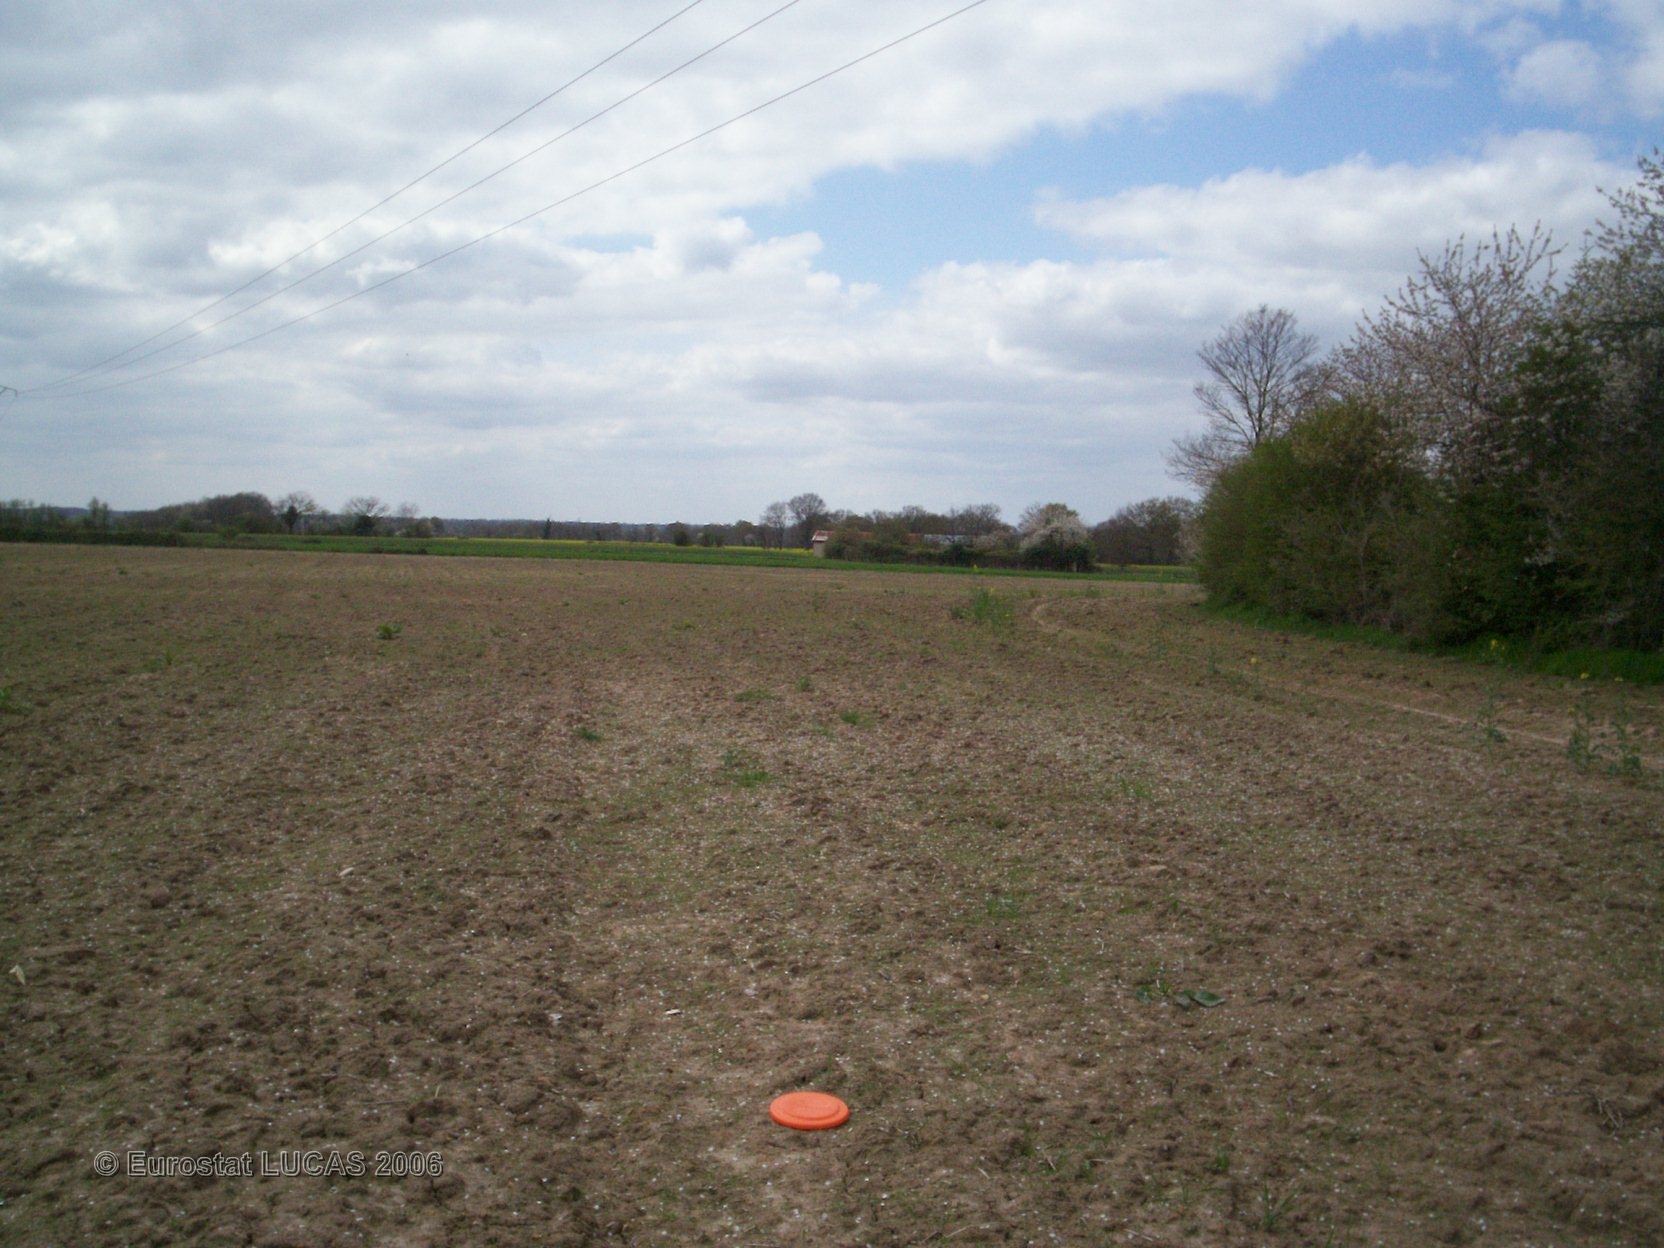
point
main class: Grassland
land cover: Grassland without tree/shrub cover
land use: Agriculture (excluding fallow land and kitchen gardens)
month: April
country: FR
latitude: 46.1849
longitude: 0.5396
